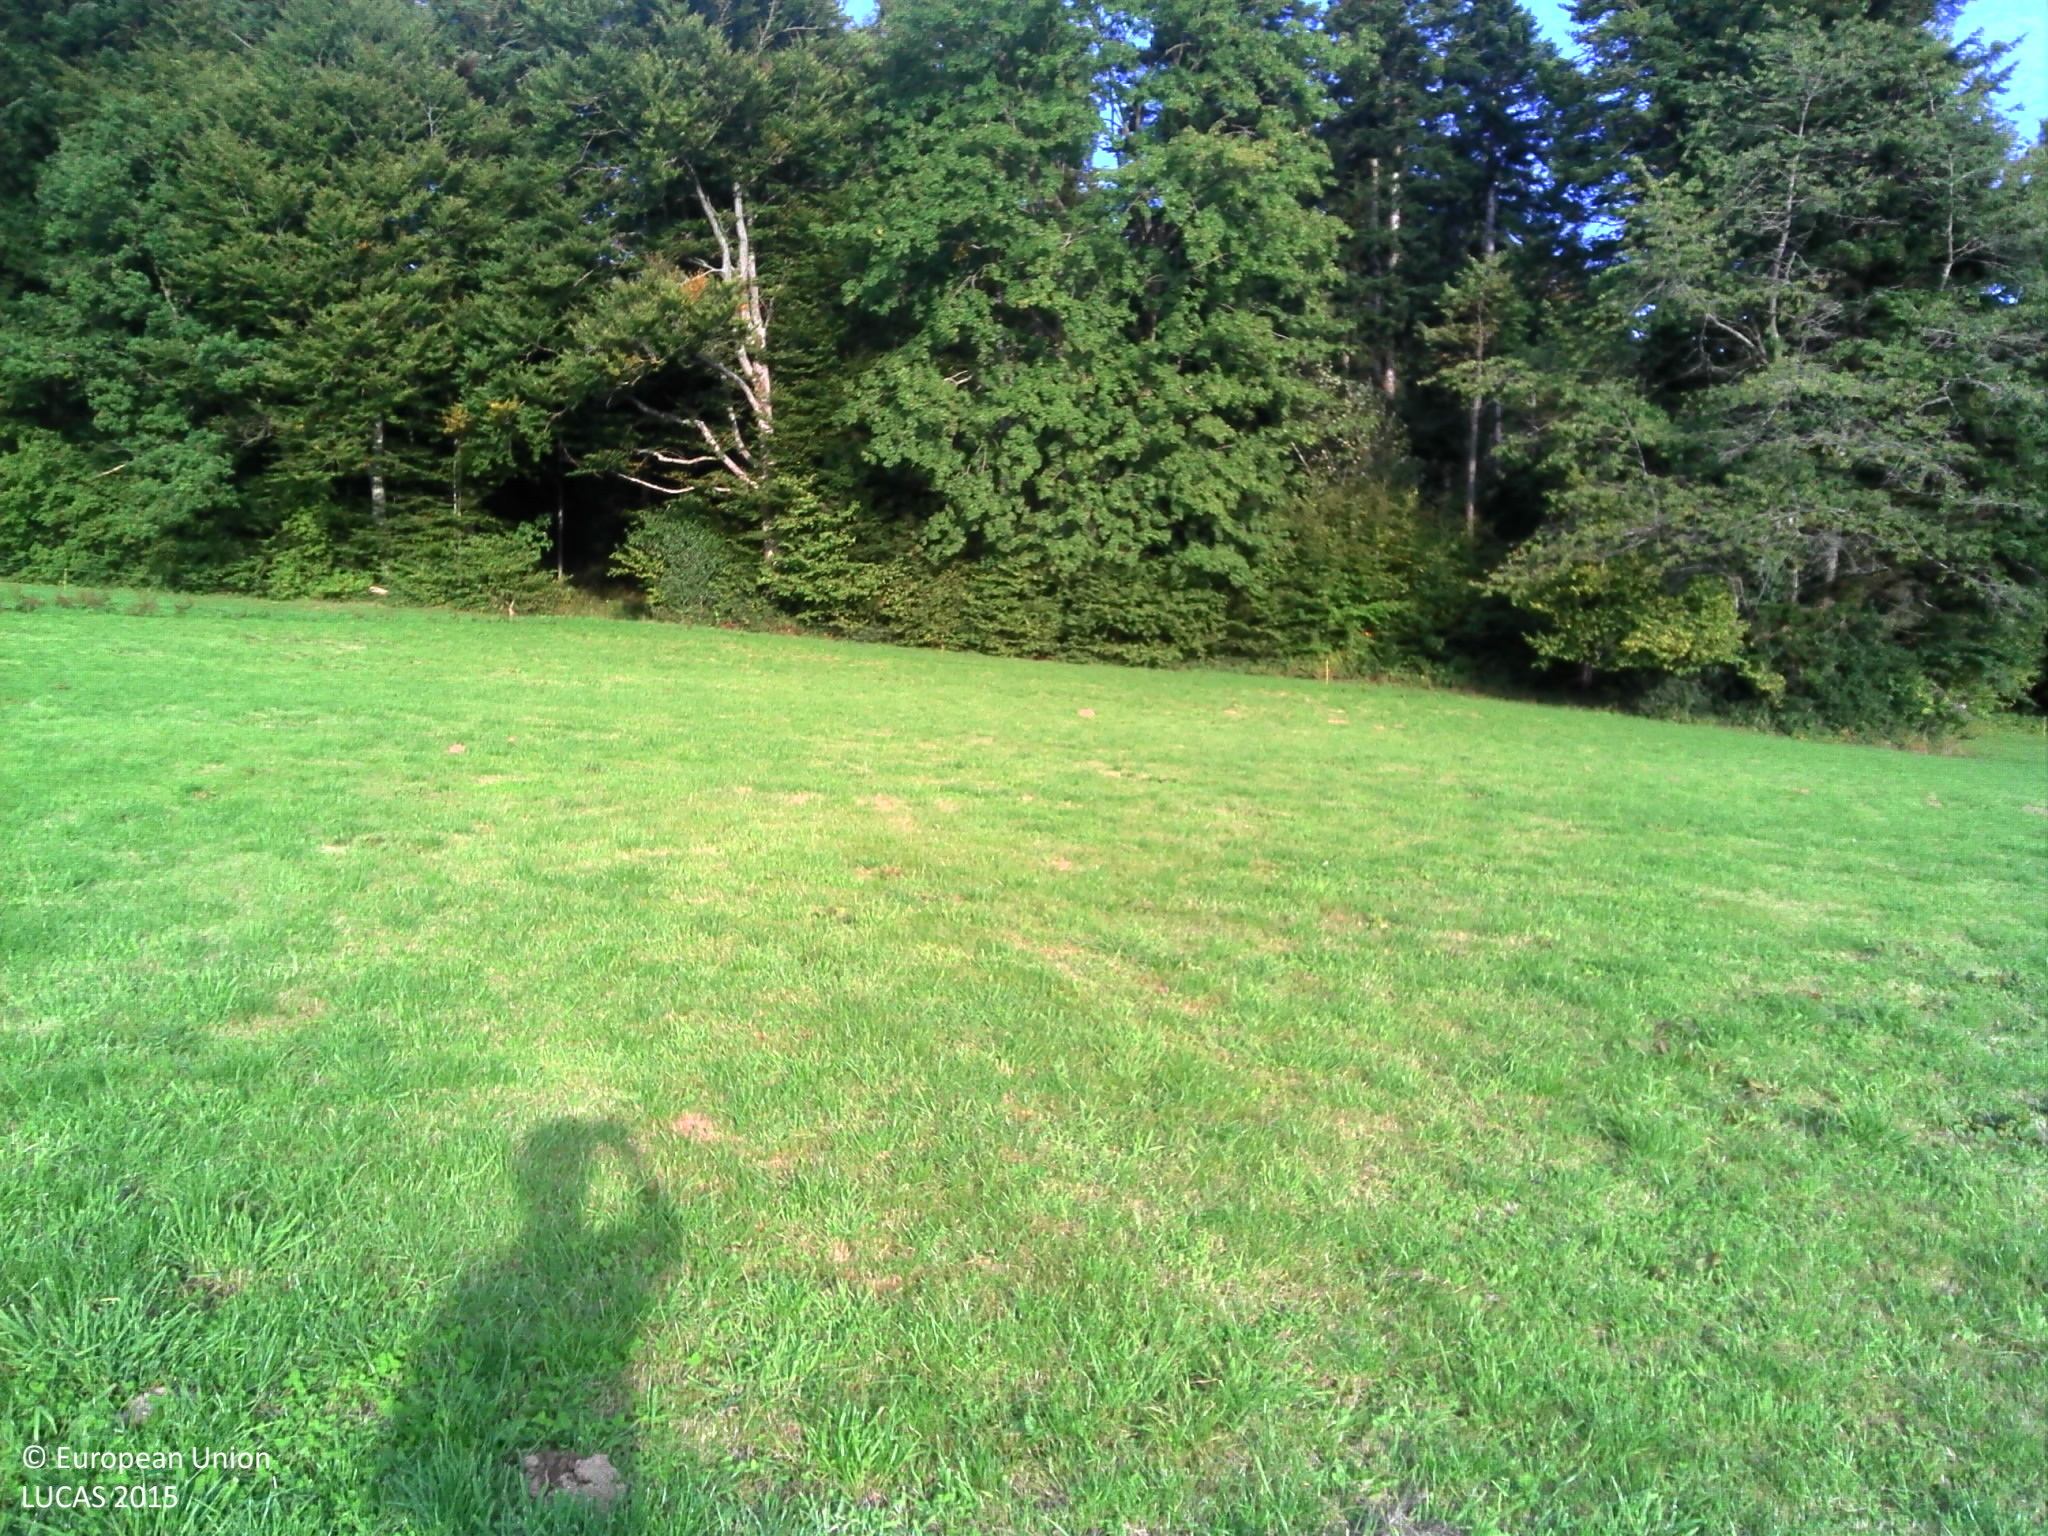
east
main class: Grassland
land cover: Grassland without tree/shrub cover
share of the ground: > 75 %
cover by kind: herbaceous plants 100 %
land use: Agriculture (excluding fallow land and kitchen gardens)
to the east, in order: Grassland without tree/shrub cover; Fences; Spruce dominated coniferous woodland
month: September
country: FR
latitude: 47.3160
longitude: 6.9195
